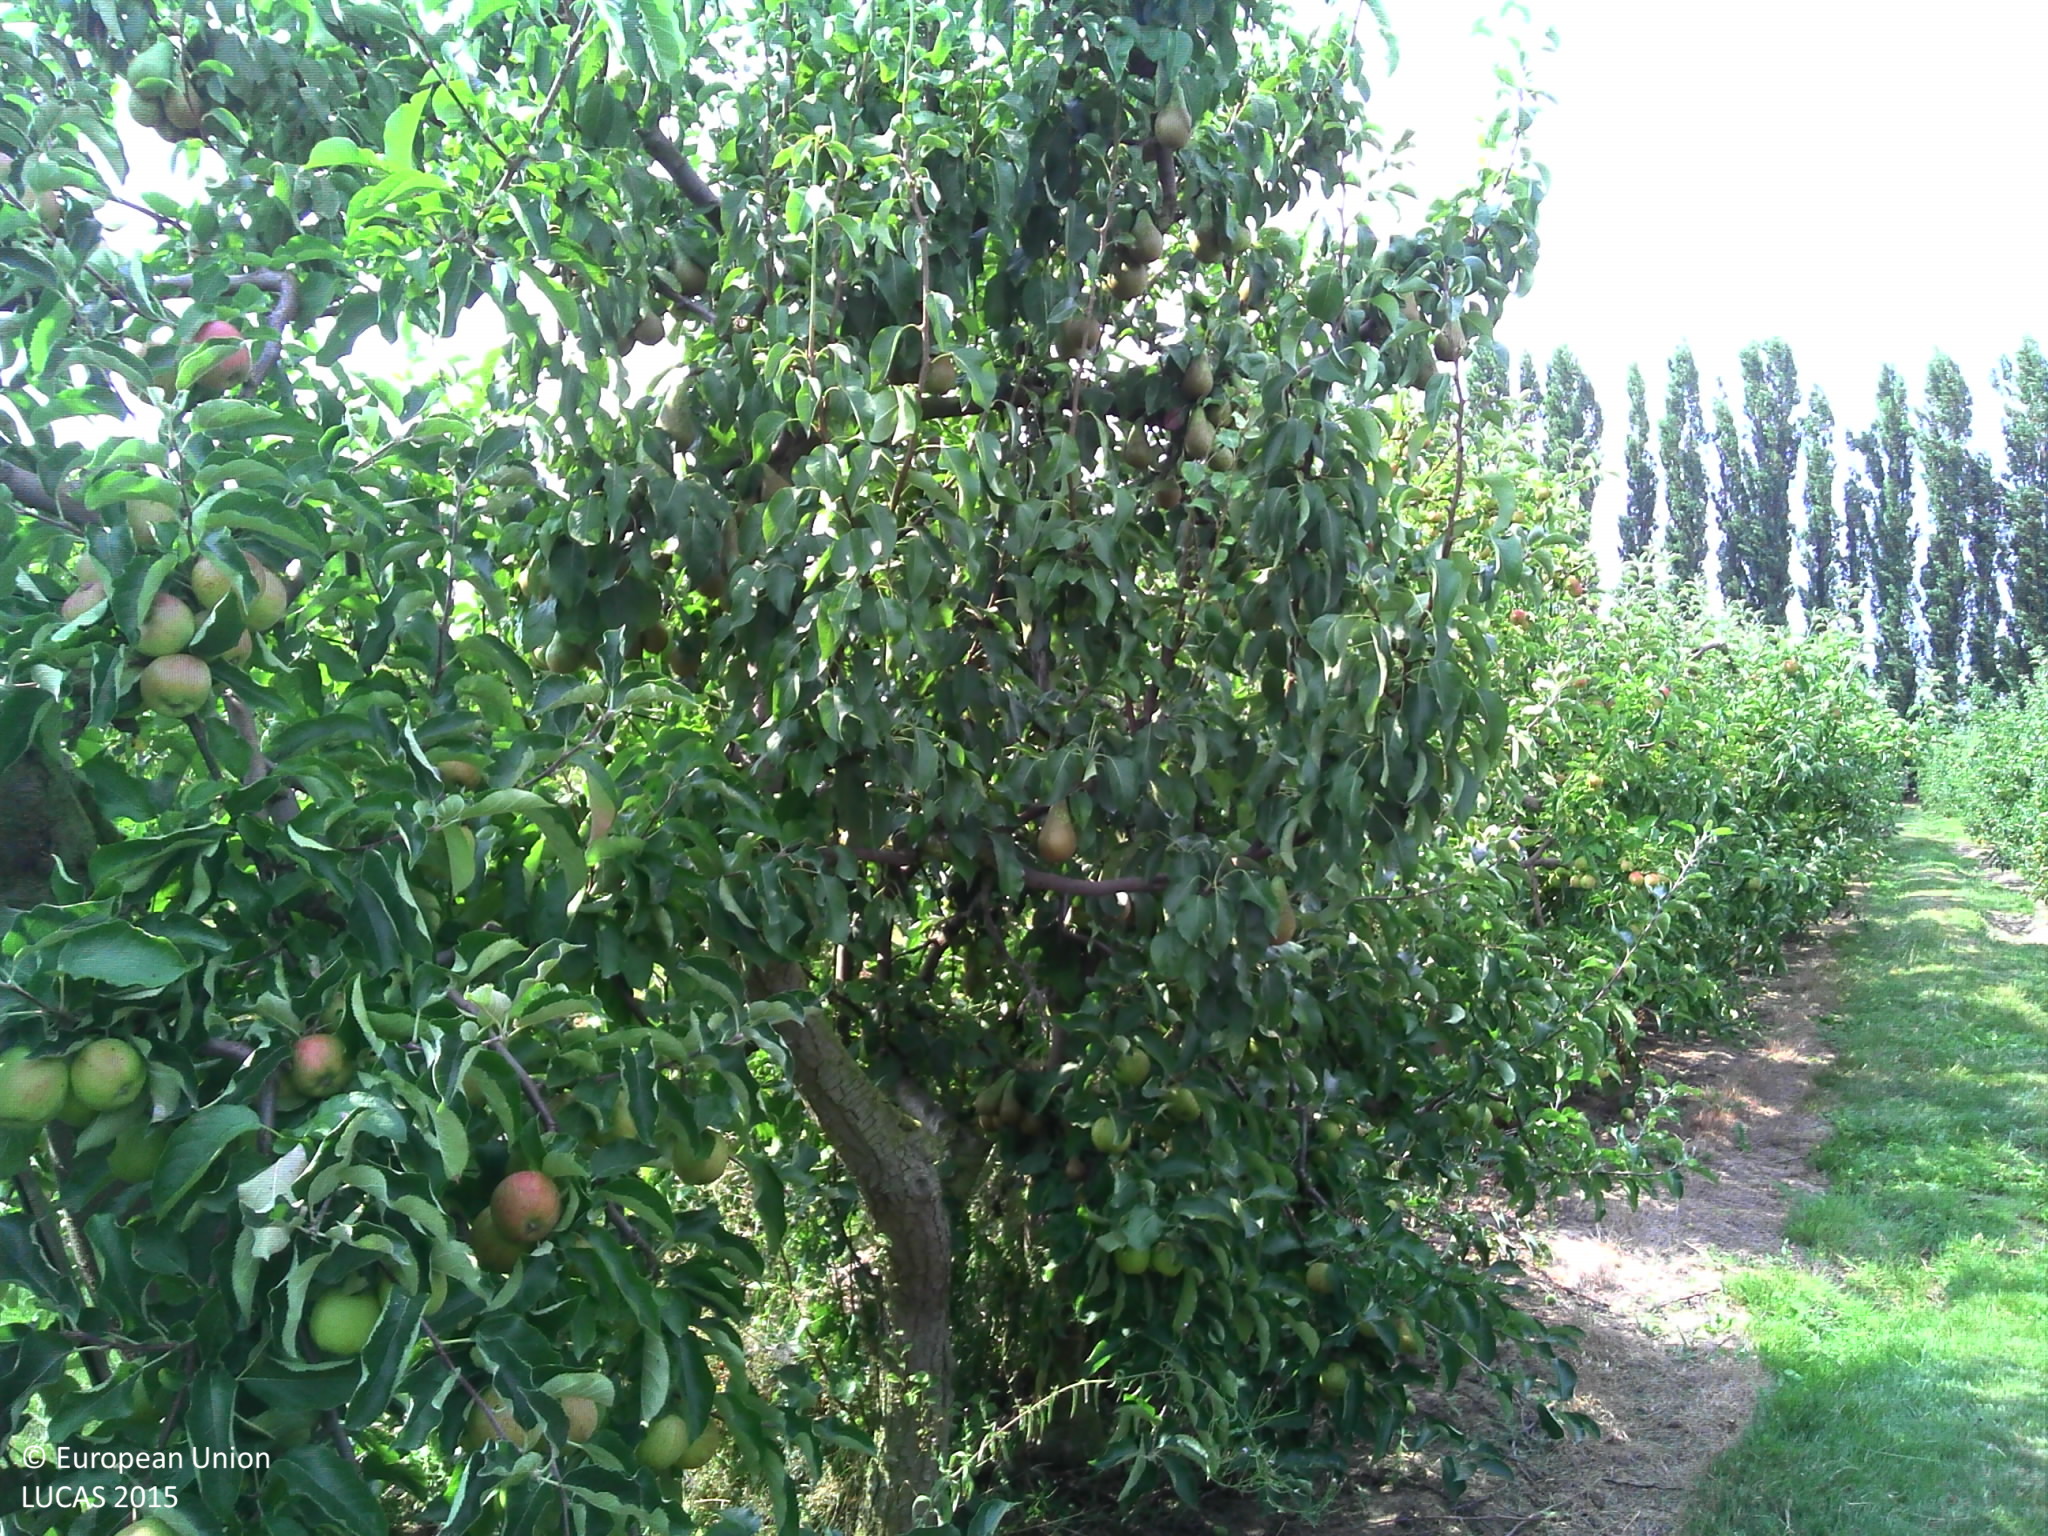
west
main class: Cropland
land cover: Apple fruit
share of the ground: 50 - 75 %
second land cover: Grassland without tree/shrub cover
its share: 25 - 50 %
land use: Agriculture (excluding fallow land and kitchen gardens)
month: August
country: FR
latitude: 50.2591
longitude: 3.6388
